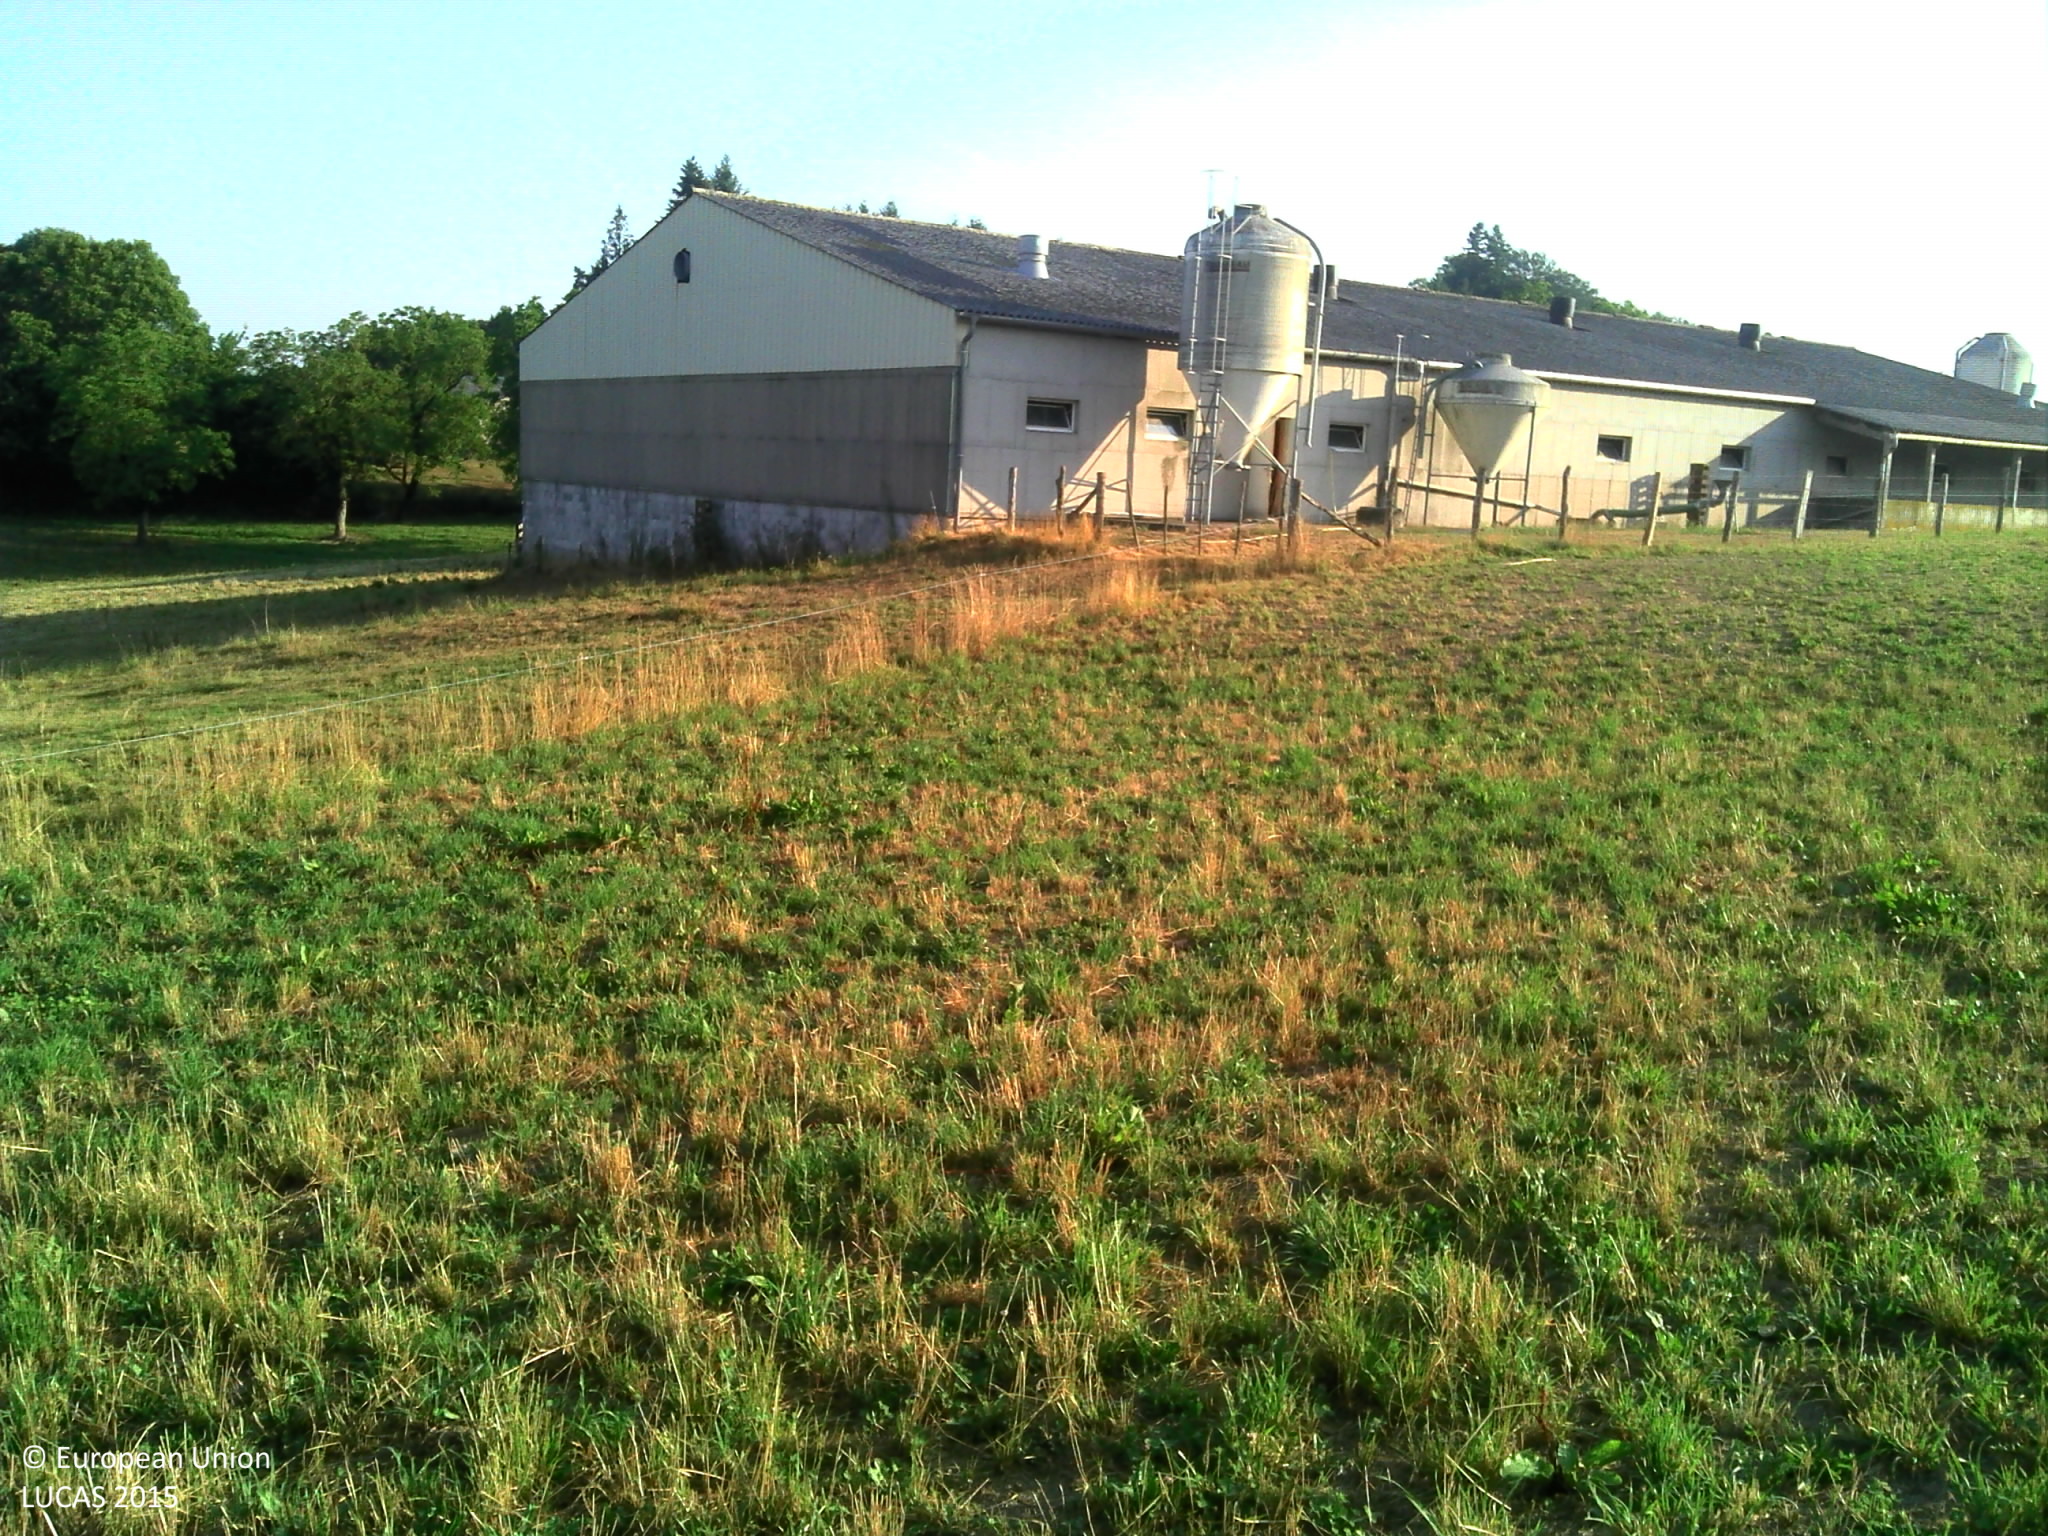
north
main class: Grassland
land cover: Grassland without tree/shrub cover
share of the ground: > 75 %
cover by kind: herbaceous plants 100 %
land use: Agriculture (excluding fallow land and kitchen gardens)
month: August
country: FR
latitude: 45.3531
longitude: 1.8652
